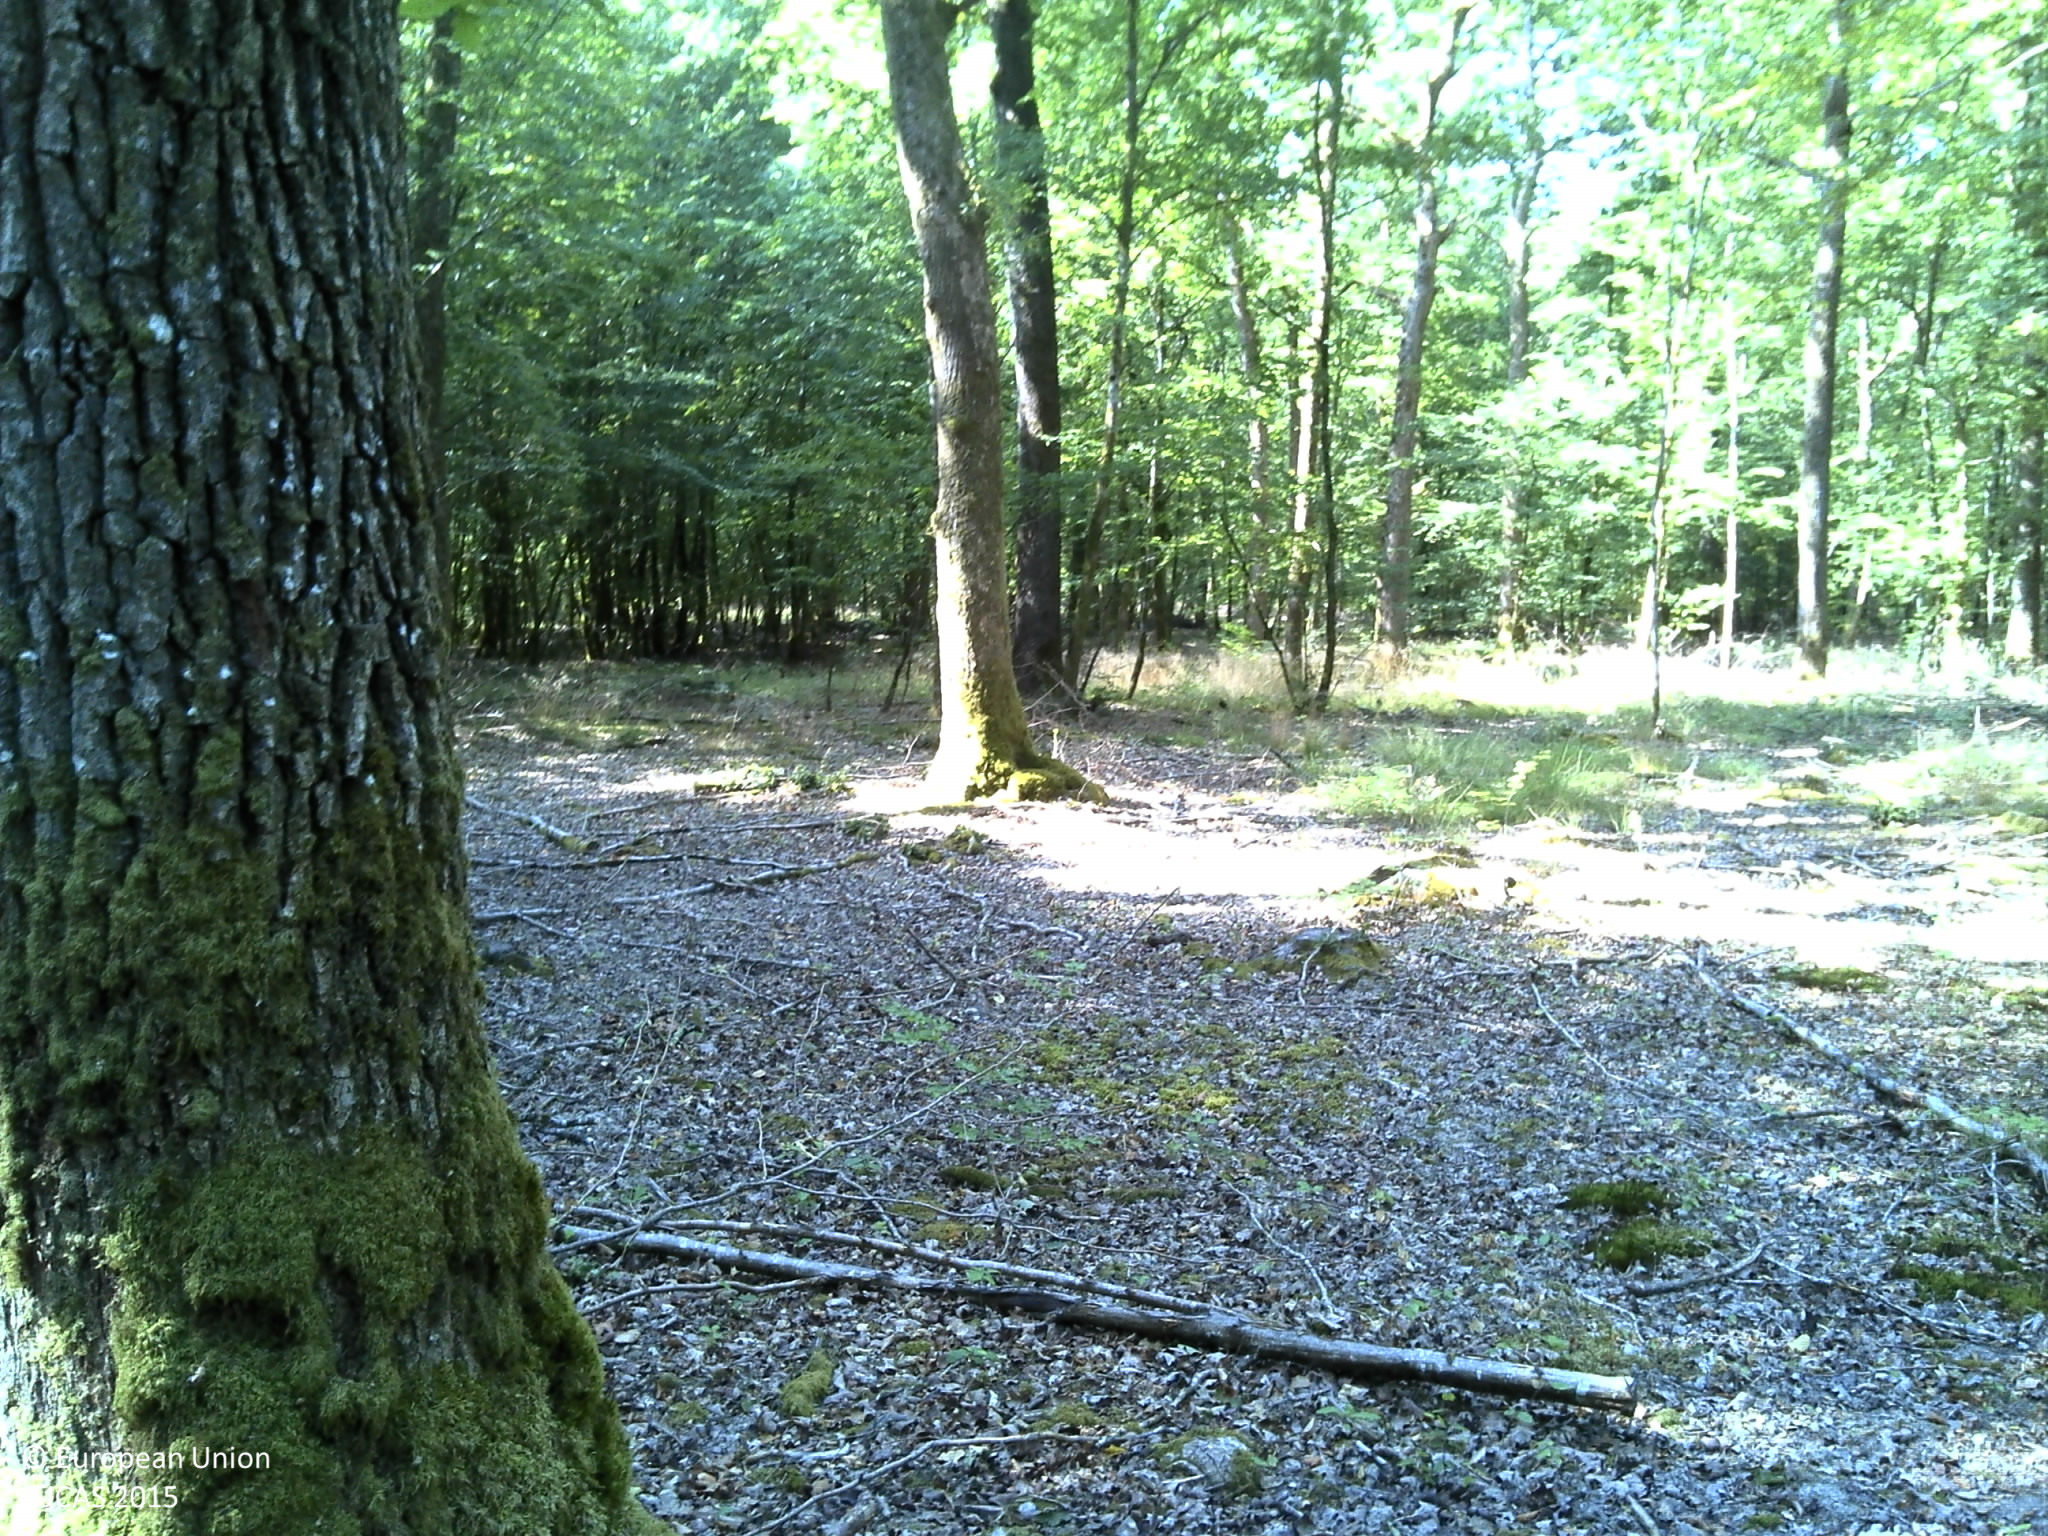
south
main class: Woodland
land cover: Broadleaved woodland
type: acidophilous oak and oak-birch forest
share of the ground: > 75 %
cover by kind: broadleaved forest trees 90 %, herbaceous plants 5 %, unconsolidated bare surface 5 %
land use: Forestry
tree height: > 5 m
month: July
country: FR
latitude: 48.0246
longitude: 5.9913
